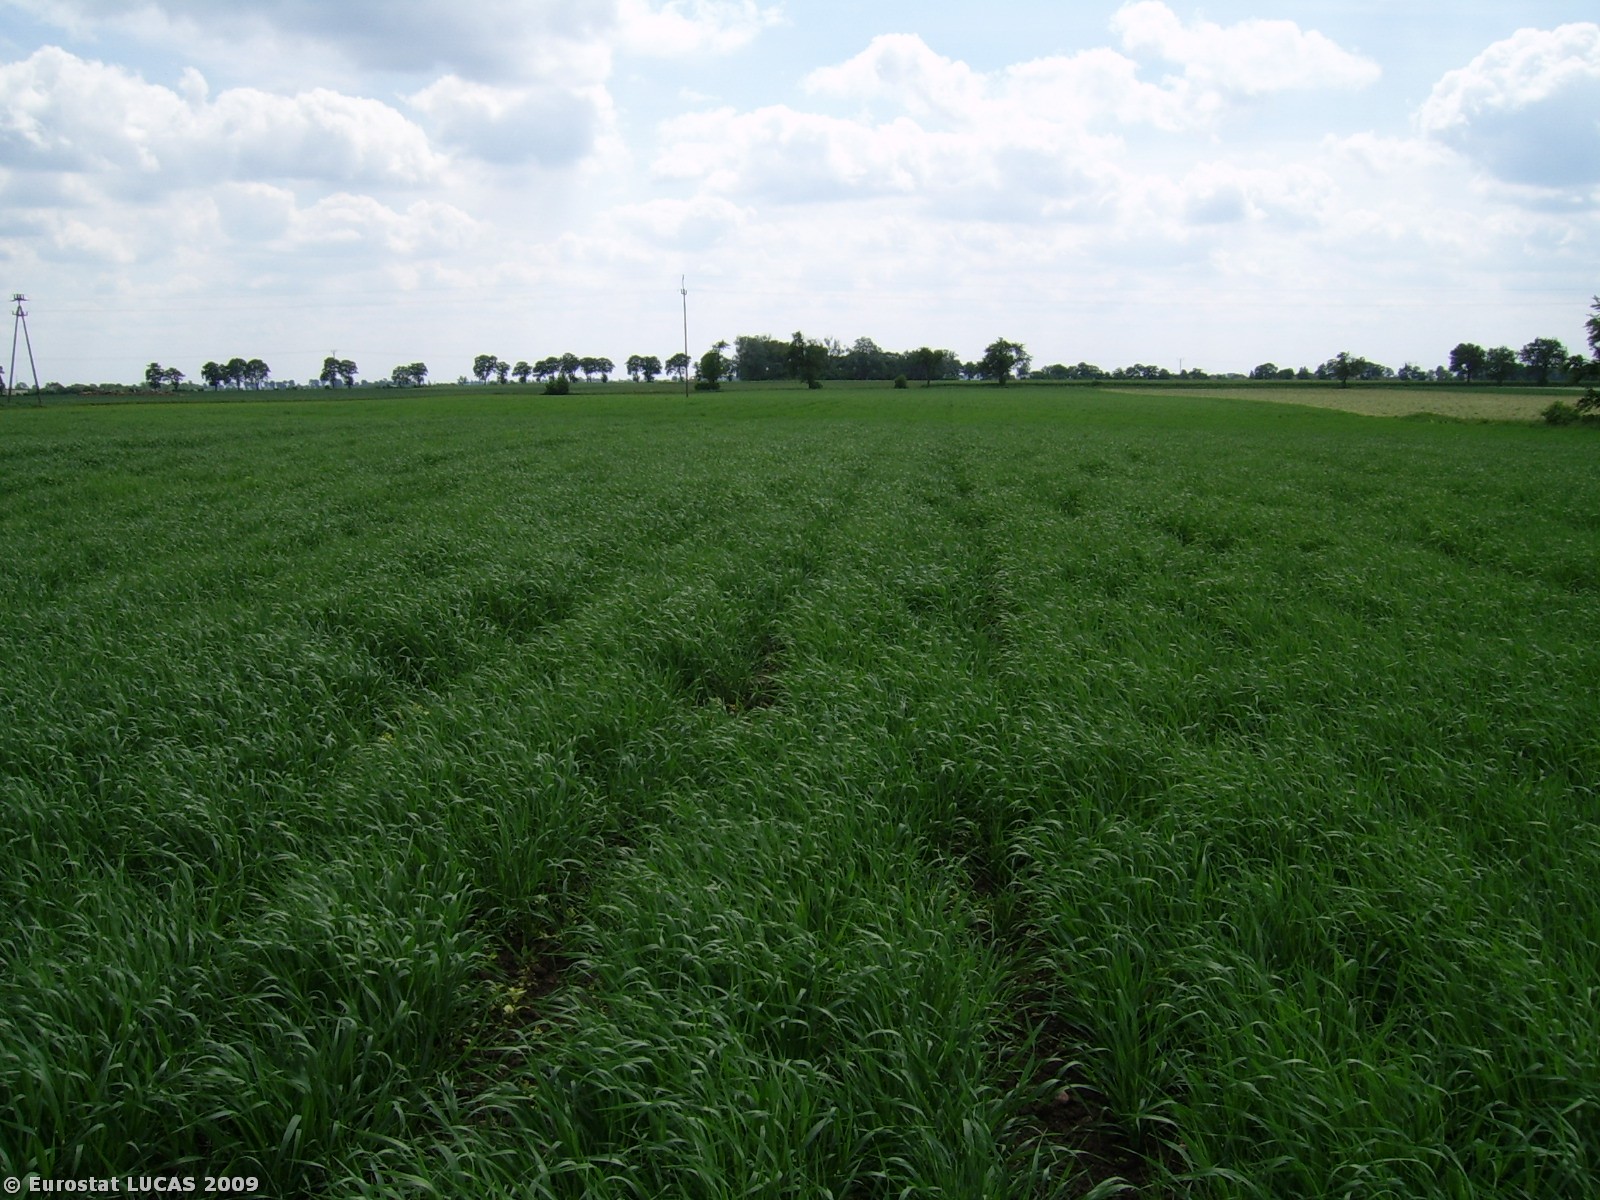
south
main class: Cropland
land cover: Barley
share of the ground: > 75 %
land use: Agriculture (excluding fallow land and kitchen gardens)
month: May
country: PL
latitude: 52.8546
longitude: 18.1695
